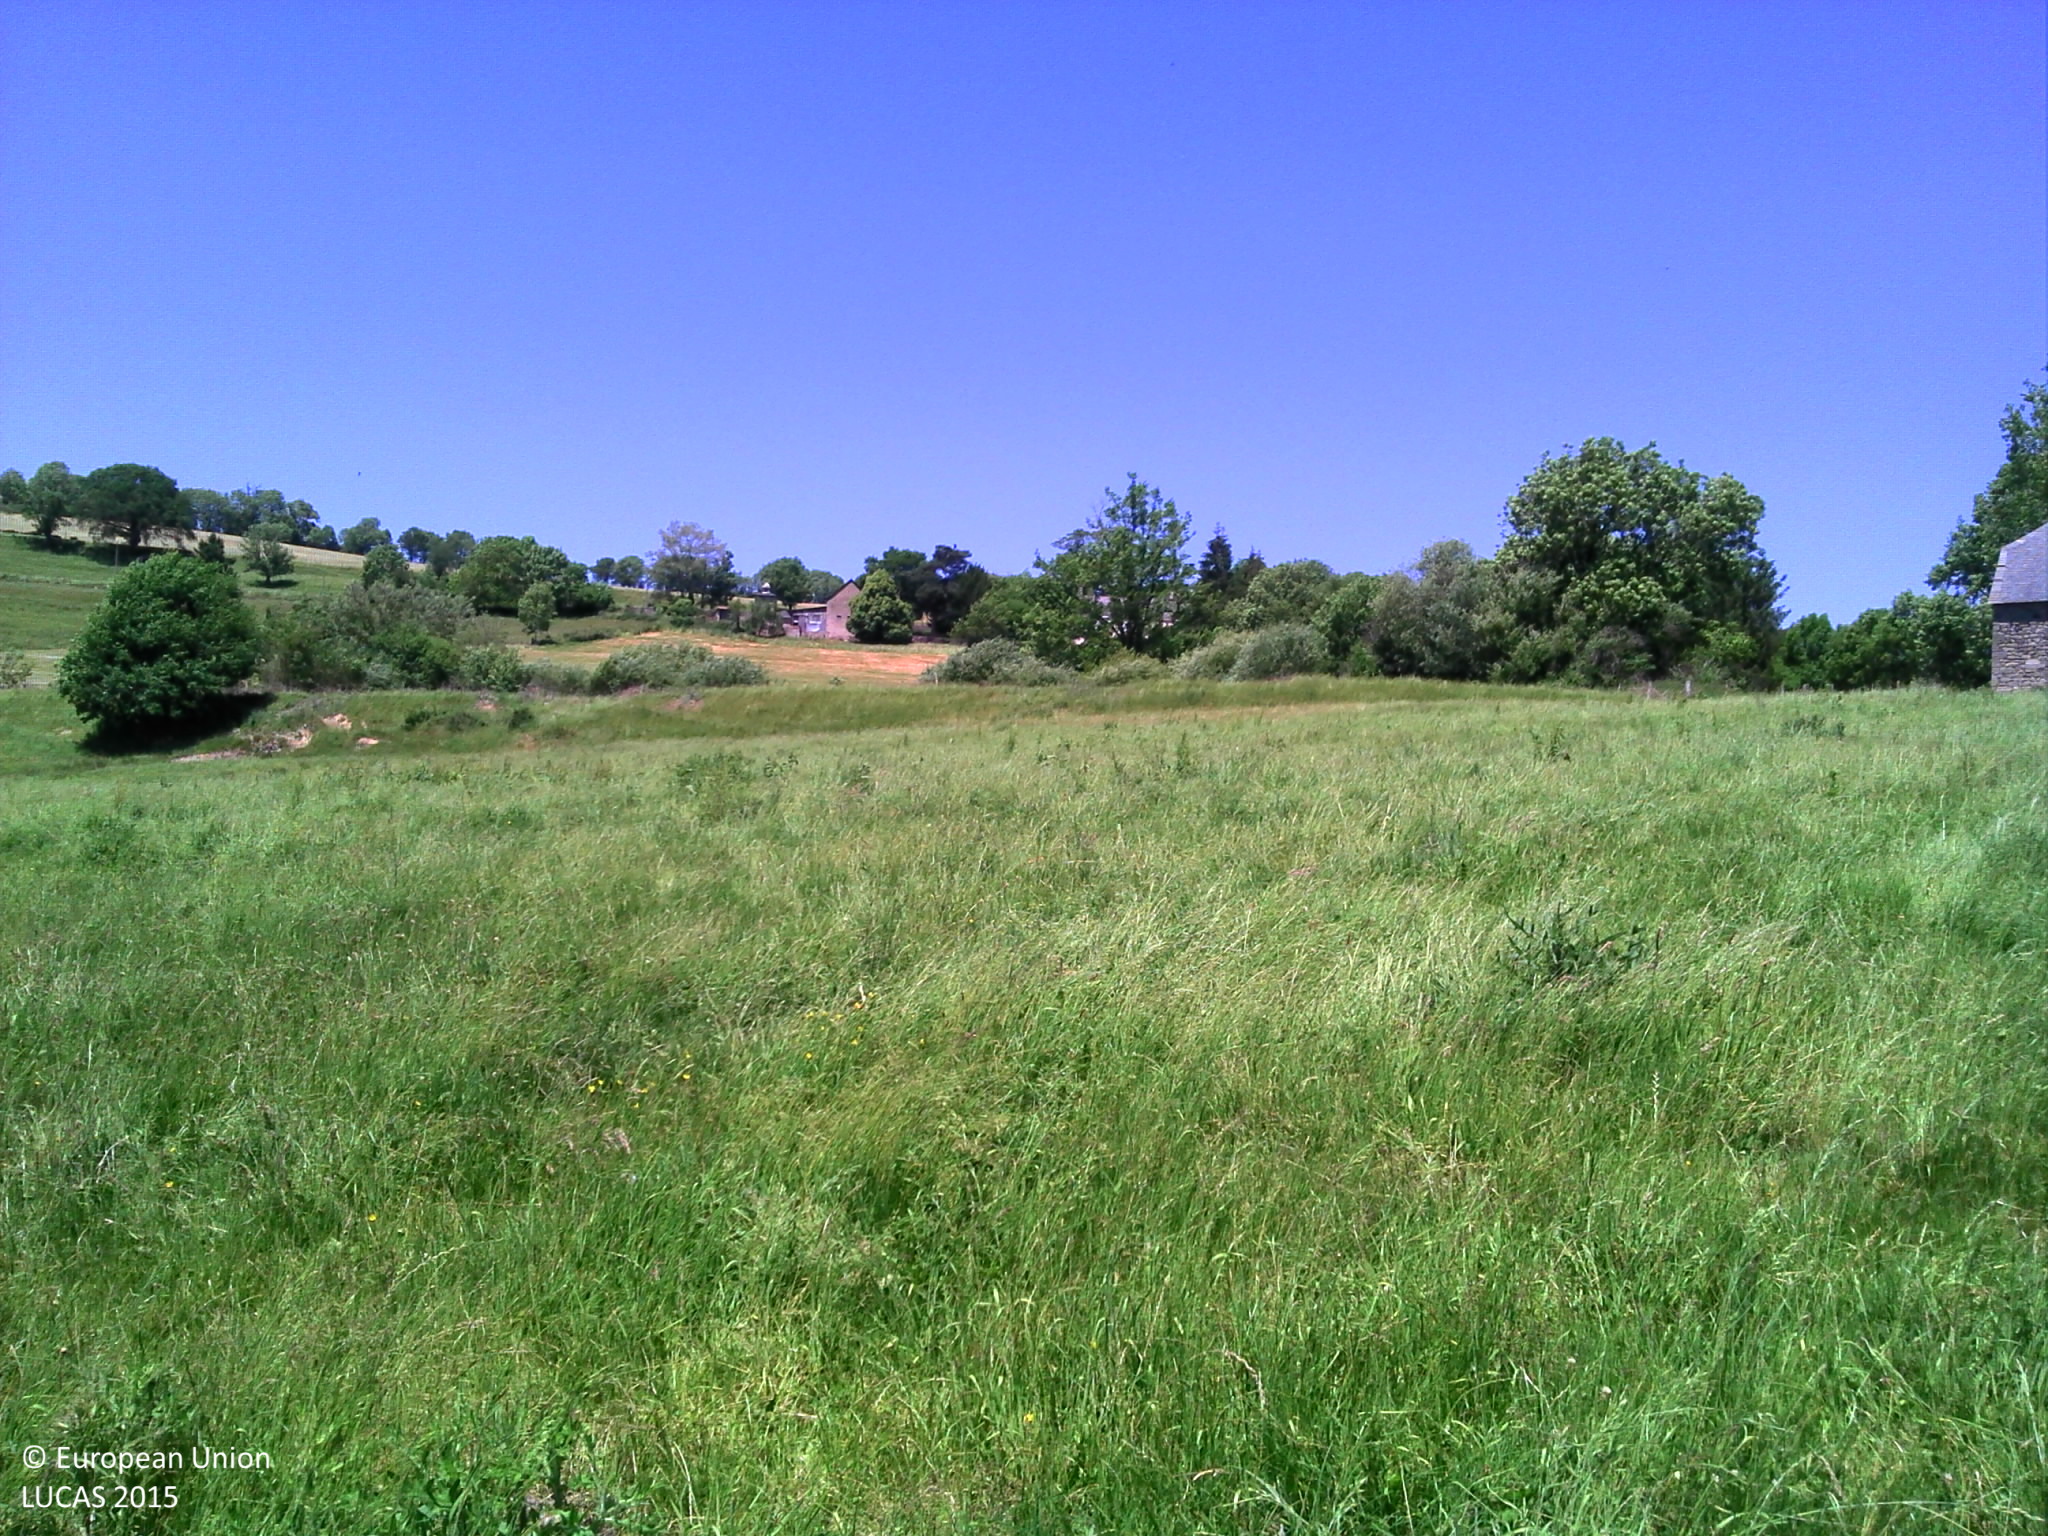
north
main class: Grassland
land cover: Grassland without tree/shrub cover
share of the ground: > 75 %
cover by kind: herbaceous plants 100 %
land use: Agriculture (excluding fallow land and kitchen gardens)
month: June
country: FR
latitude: 45.3590
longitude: 2.4286
